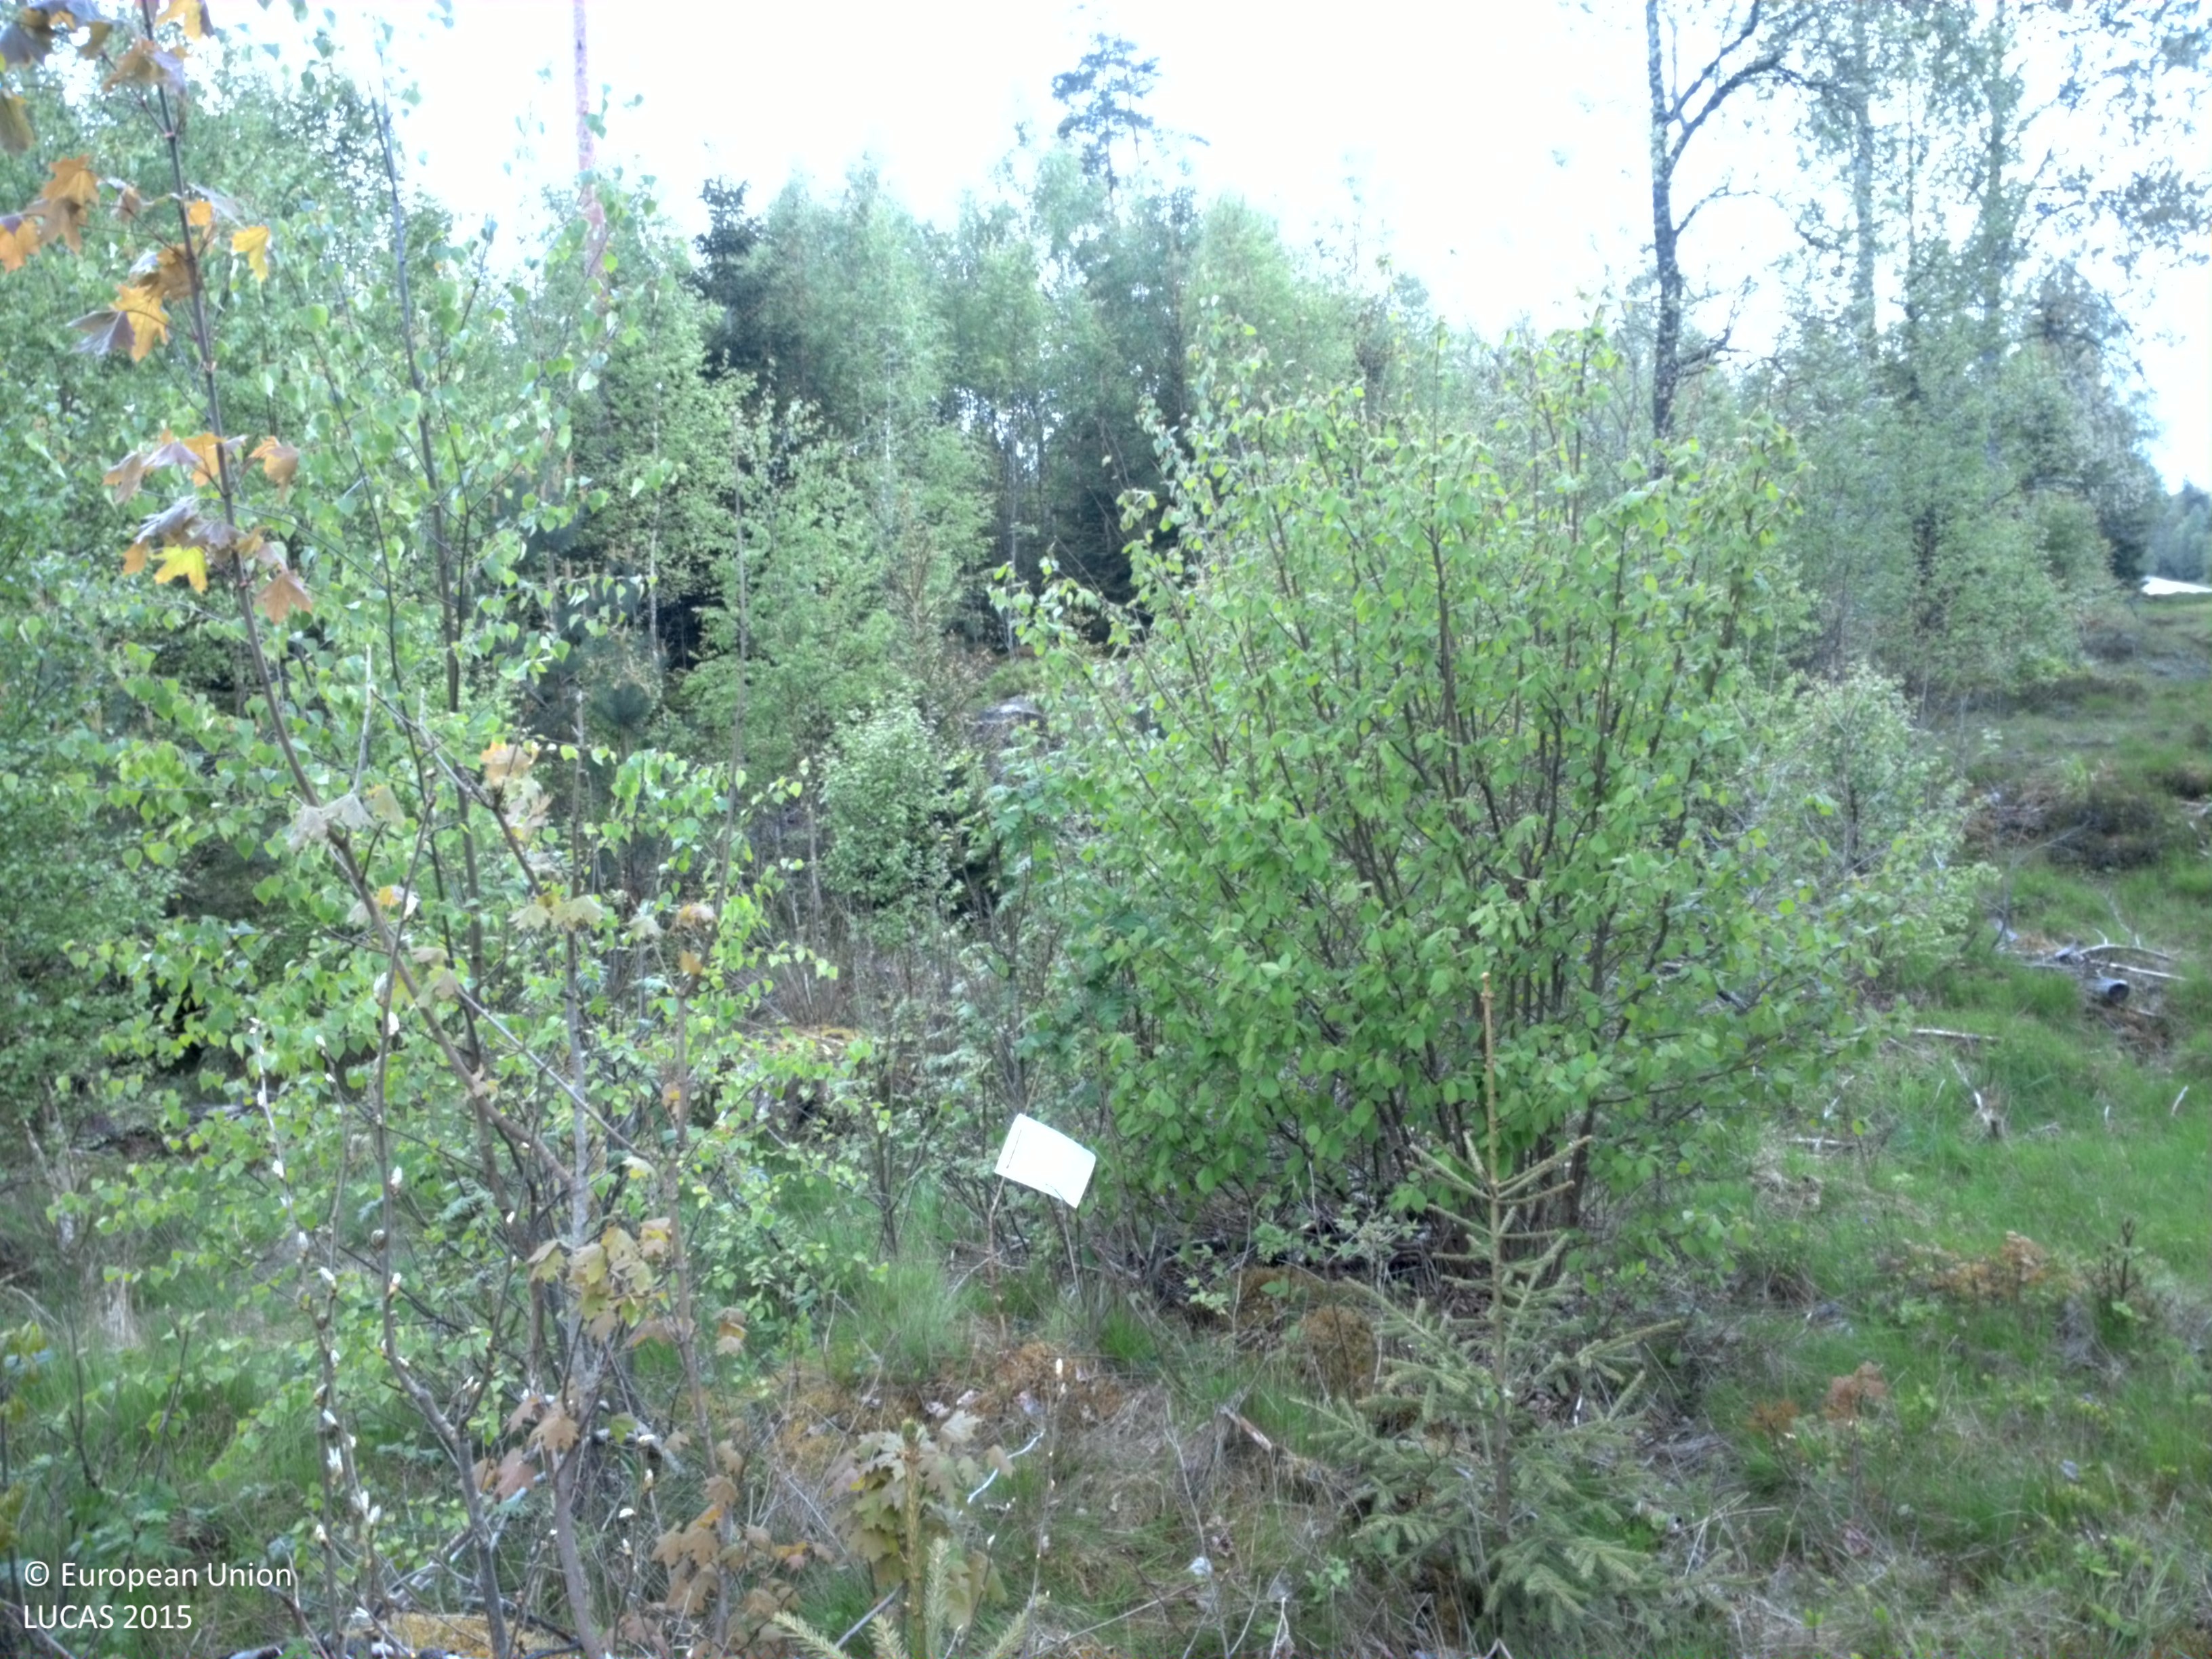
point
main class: Woodland
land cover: Spruce dominated mixed woodland
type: boreal forest
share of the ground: 50 - 75 %
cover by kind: broadleaved forest trees 35 %, coniferous forest trees 25 %, herbaceous plants 25 %, shrubs 10 %, lichens and mosses 5 %
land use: Forestry
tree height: < 5 m
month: June
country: SE
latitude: 56.8178
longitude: 14.3054
